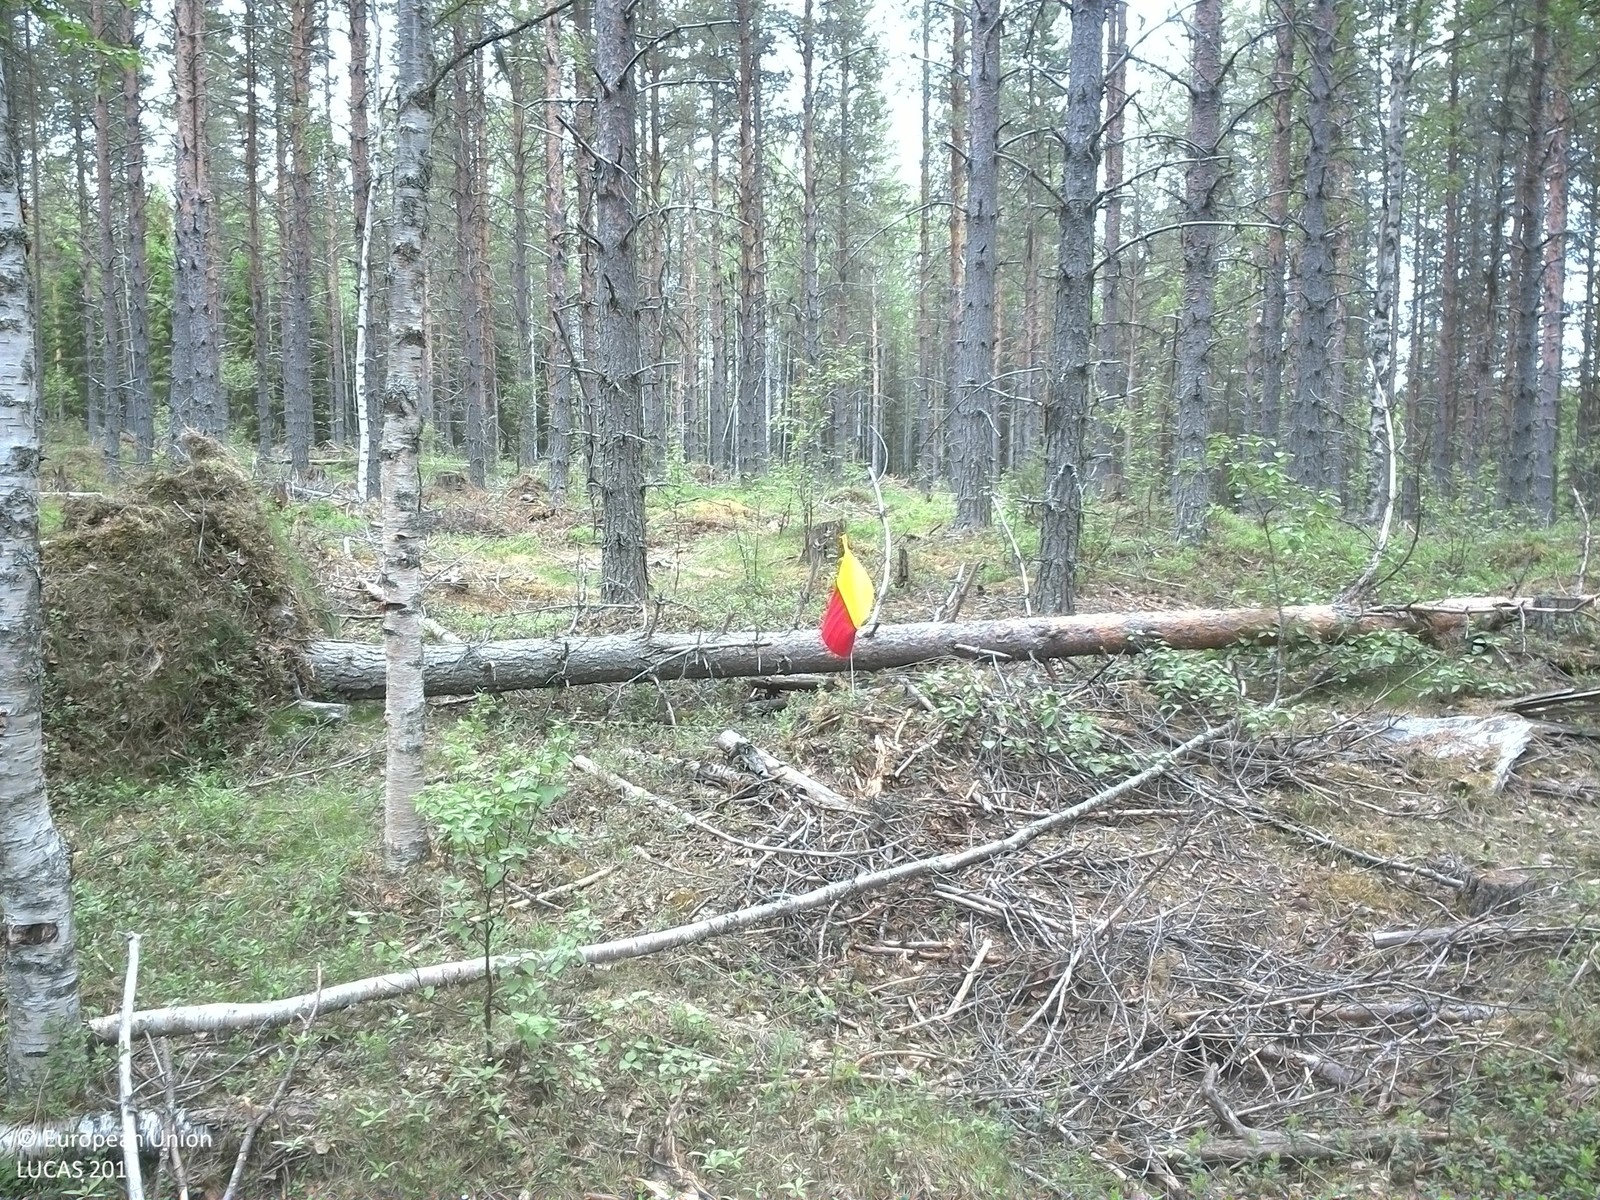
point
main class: Woodland
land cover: Pine dominated coniferous woodland
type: boreal forest
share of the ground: 25 - 50 %
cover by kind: shrubs 35 %, coniferous forest trees 30 %, herbaceous plants 15 %, lichens and mosses 10 %, broadleaved forest trees 5 %, unconsolidated bare surface 5 %
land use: Forestry
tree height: > 5 m
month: July
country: SE
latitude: 64.1610
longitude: 16.8175
